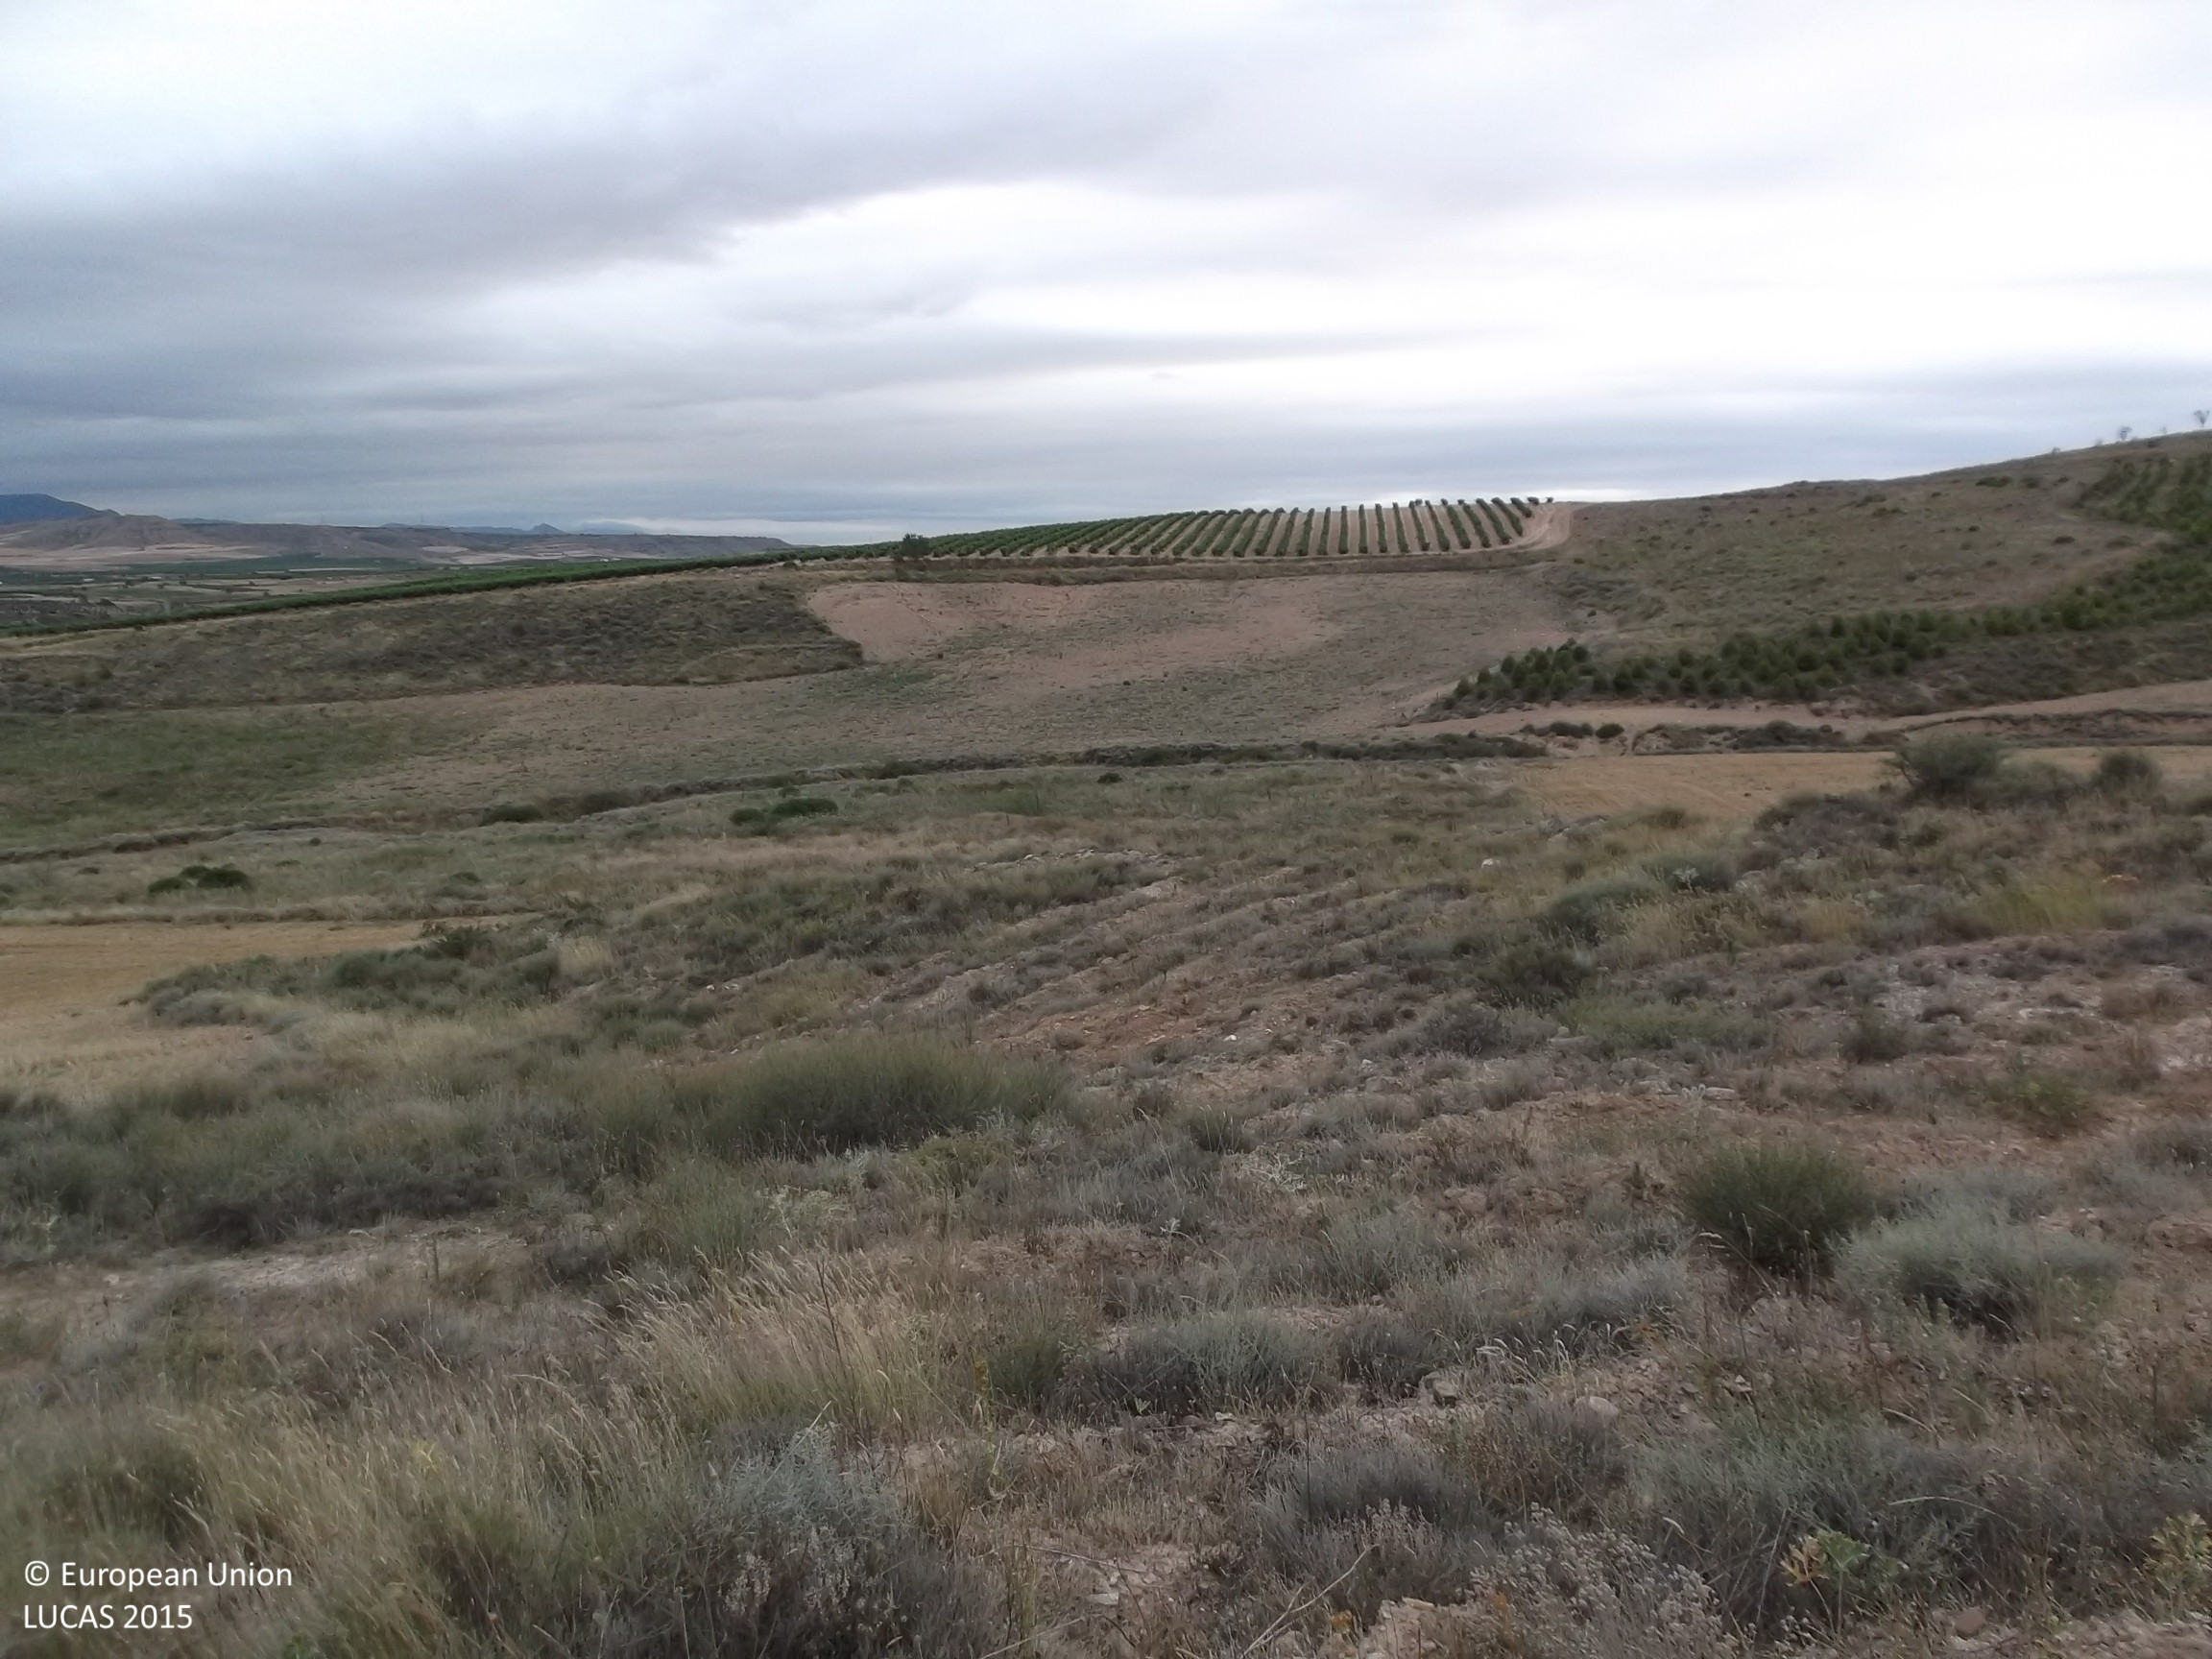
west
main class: Shrubland
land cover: Shrubland without tree cover
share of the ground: 50 - 75 %
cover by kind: shrubs 50 %, herbaceous plants 40 %, unconsolidated bare surface 10 %
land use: Semi-natural and natural areas not in use
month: July
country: ES
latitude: 42.3908
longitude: -2.1762
